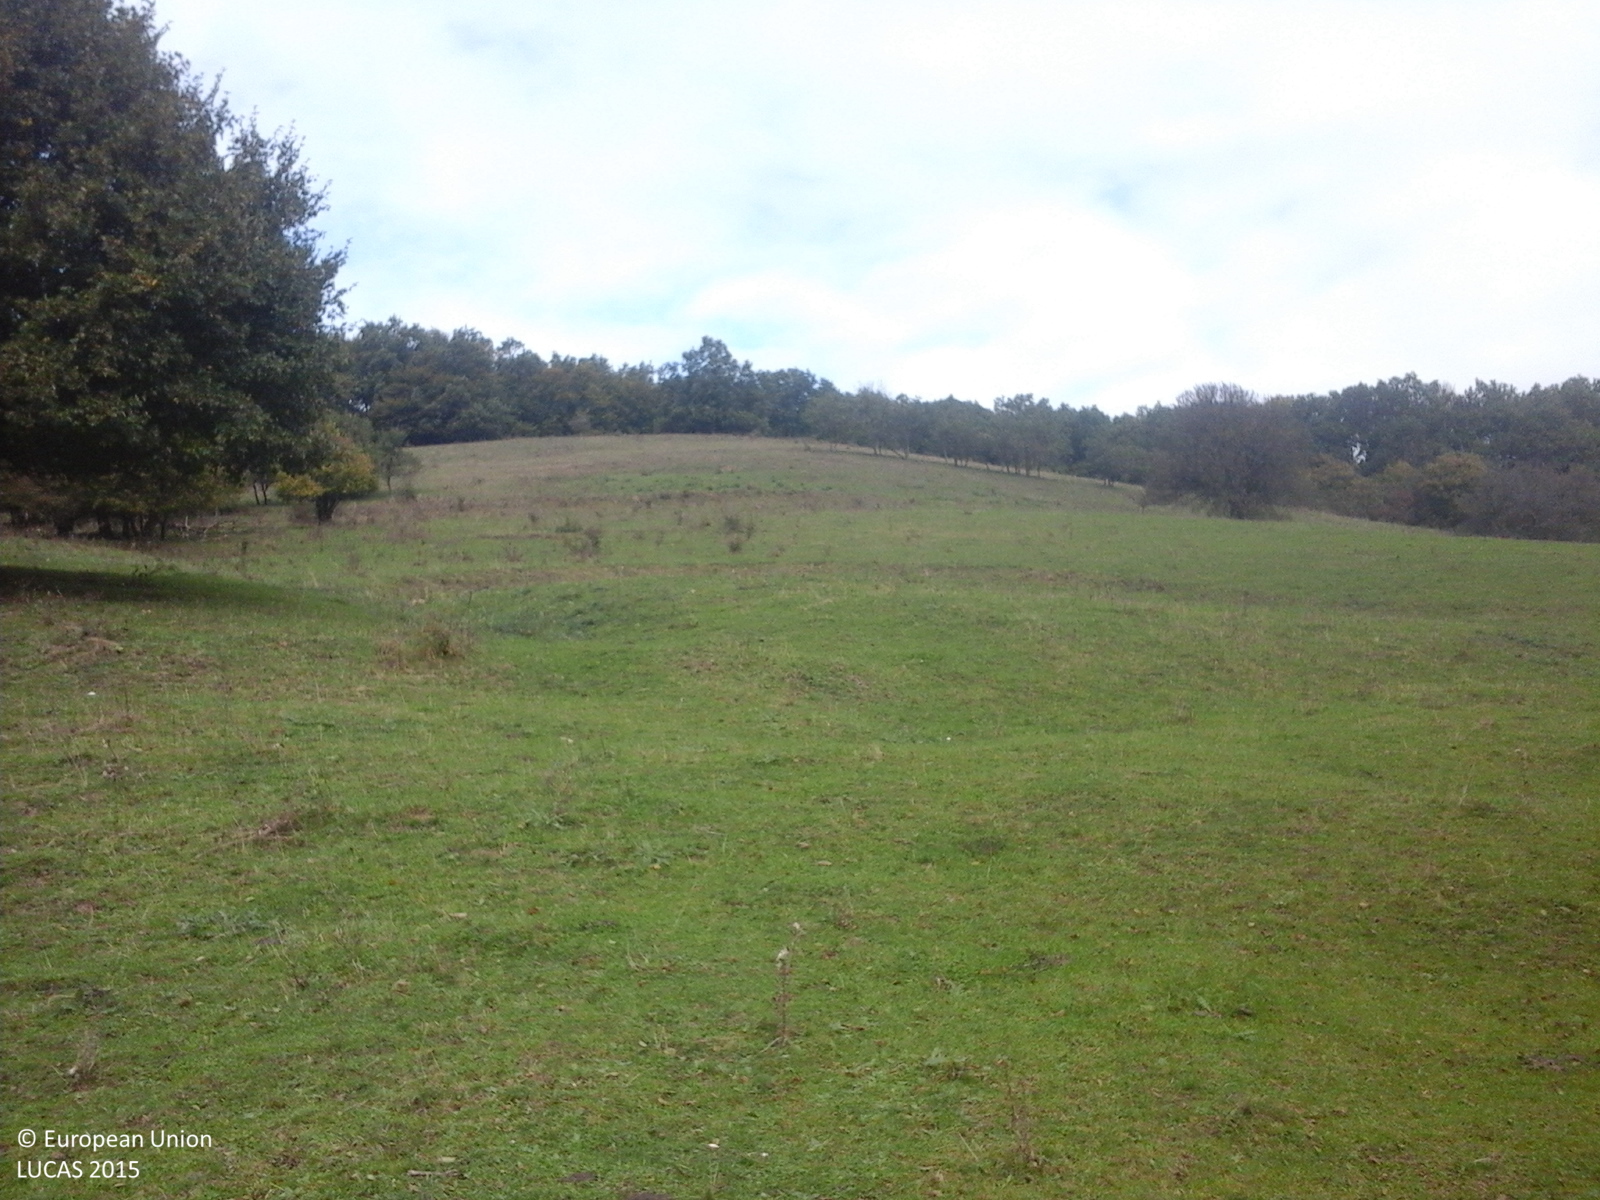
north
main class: Grassland
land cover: Grassland without tree/shrub cover
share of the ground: > 75 %
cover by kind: herbaceous plants 100 %
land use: Agriculture (excluding fallow land and kitchen gardens)
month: October
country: RO
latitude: 45.8868
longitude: 24.7652
